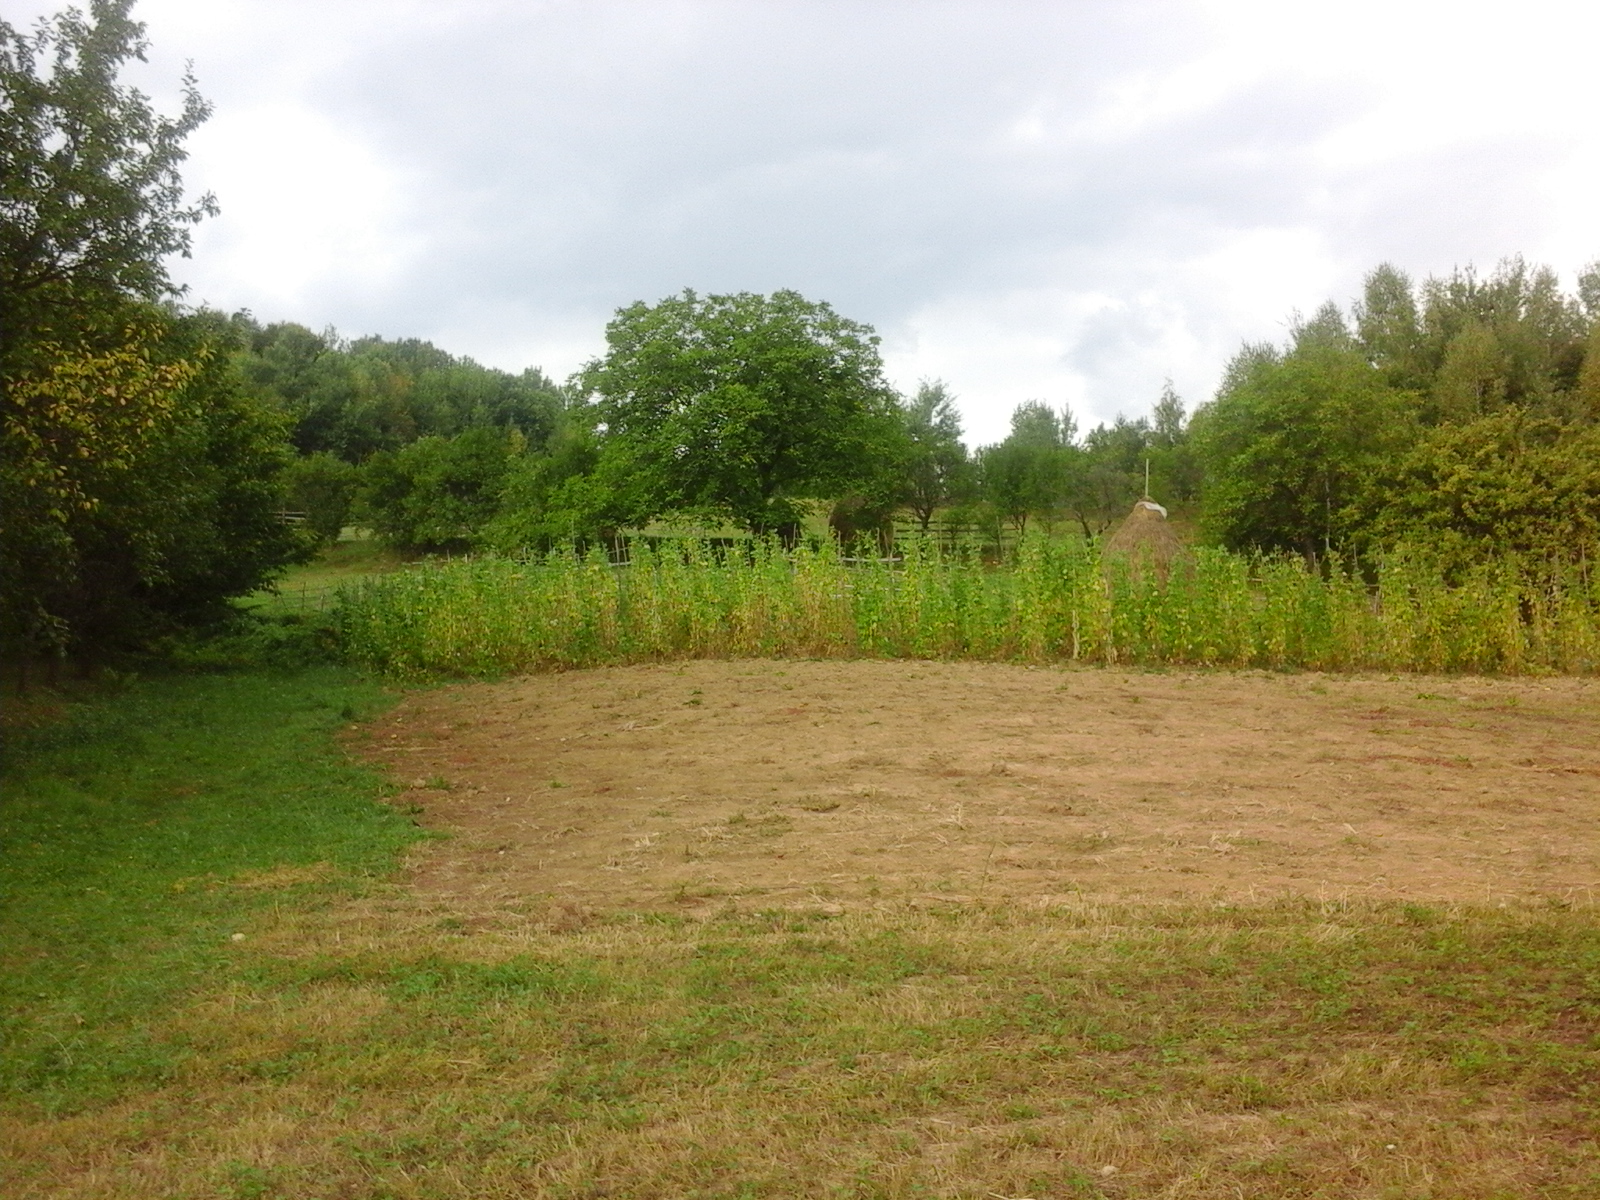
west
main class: Grassland
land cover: Grassland without tree/shrub cover
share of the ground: > 75 %
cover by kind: herbaceous plants 100 %
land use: Agriculture (excluding fallow land and kitchen gardens)
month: September
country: RO
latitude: 47.7174
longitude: 24.0693
